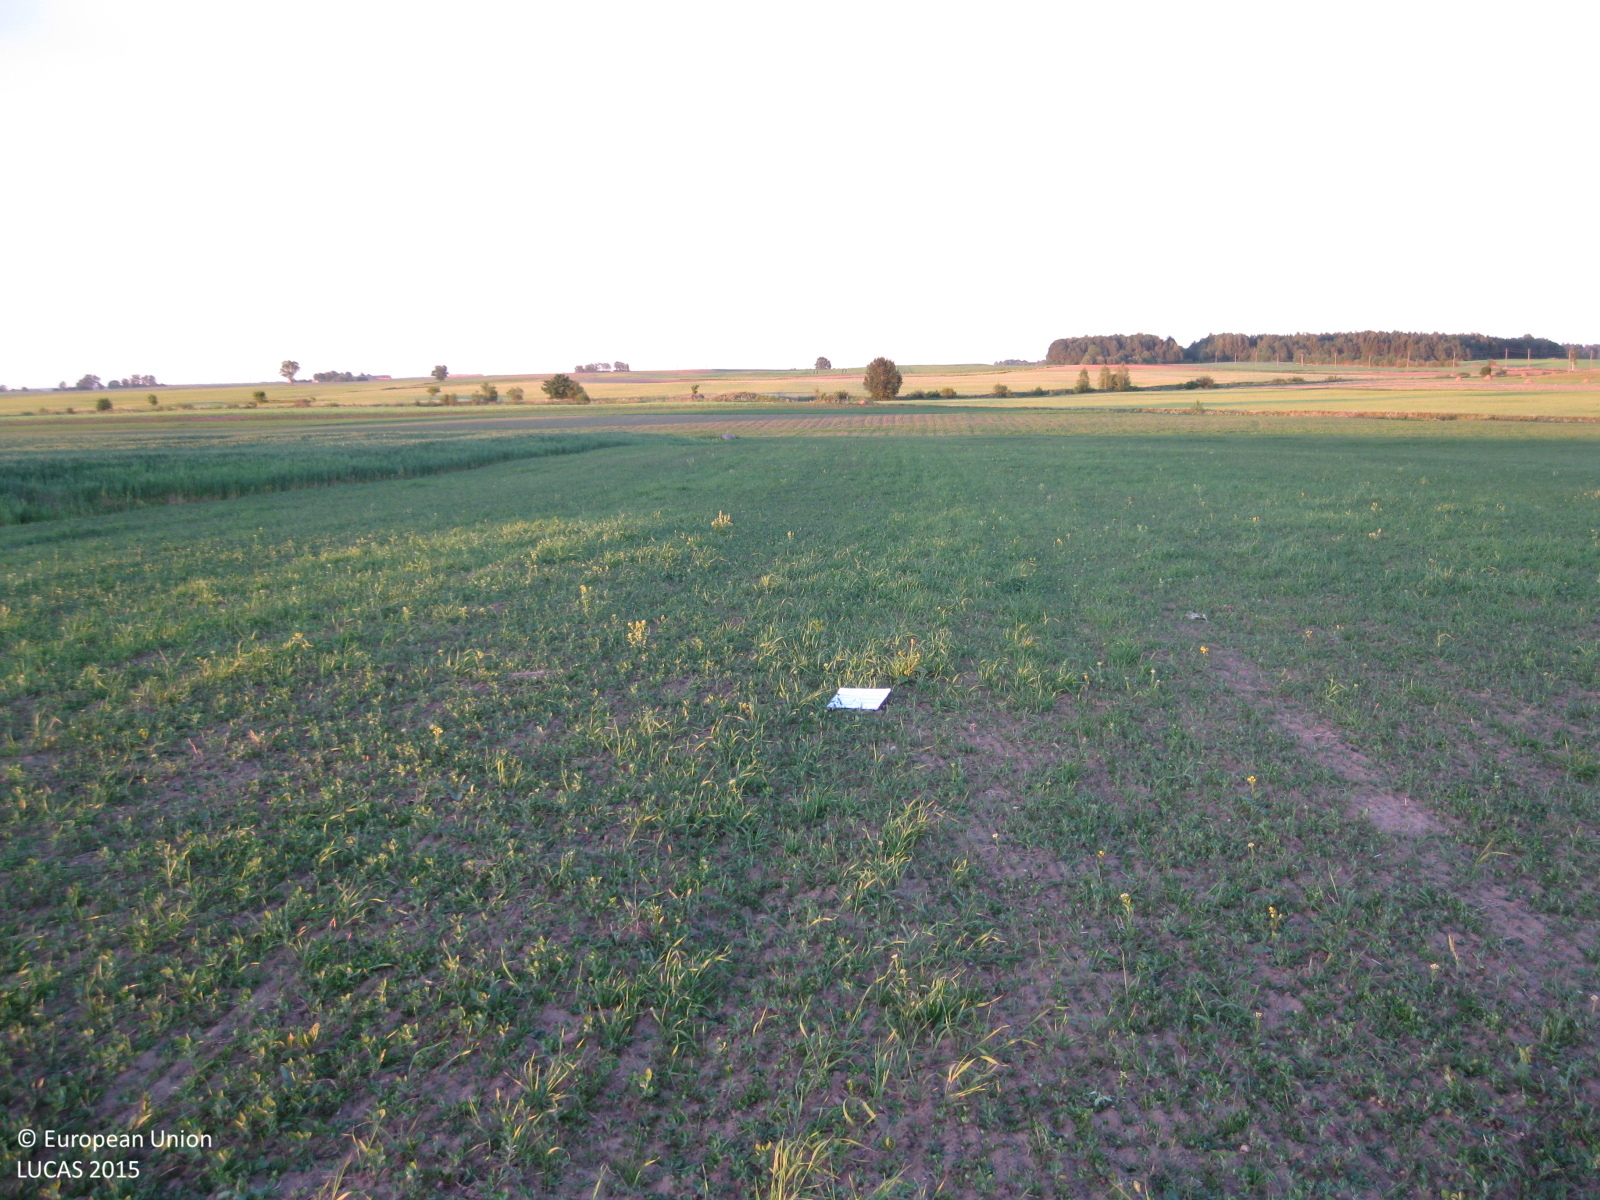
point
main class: Cropland
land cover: Rape and turnip rape
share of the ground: 25 - 50 %
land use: Agriculture (excluding fallow land and kitchen gardens)
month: June
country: LT
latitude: 55.5049
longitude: 23.6829
